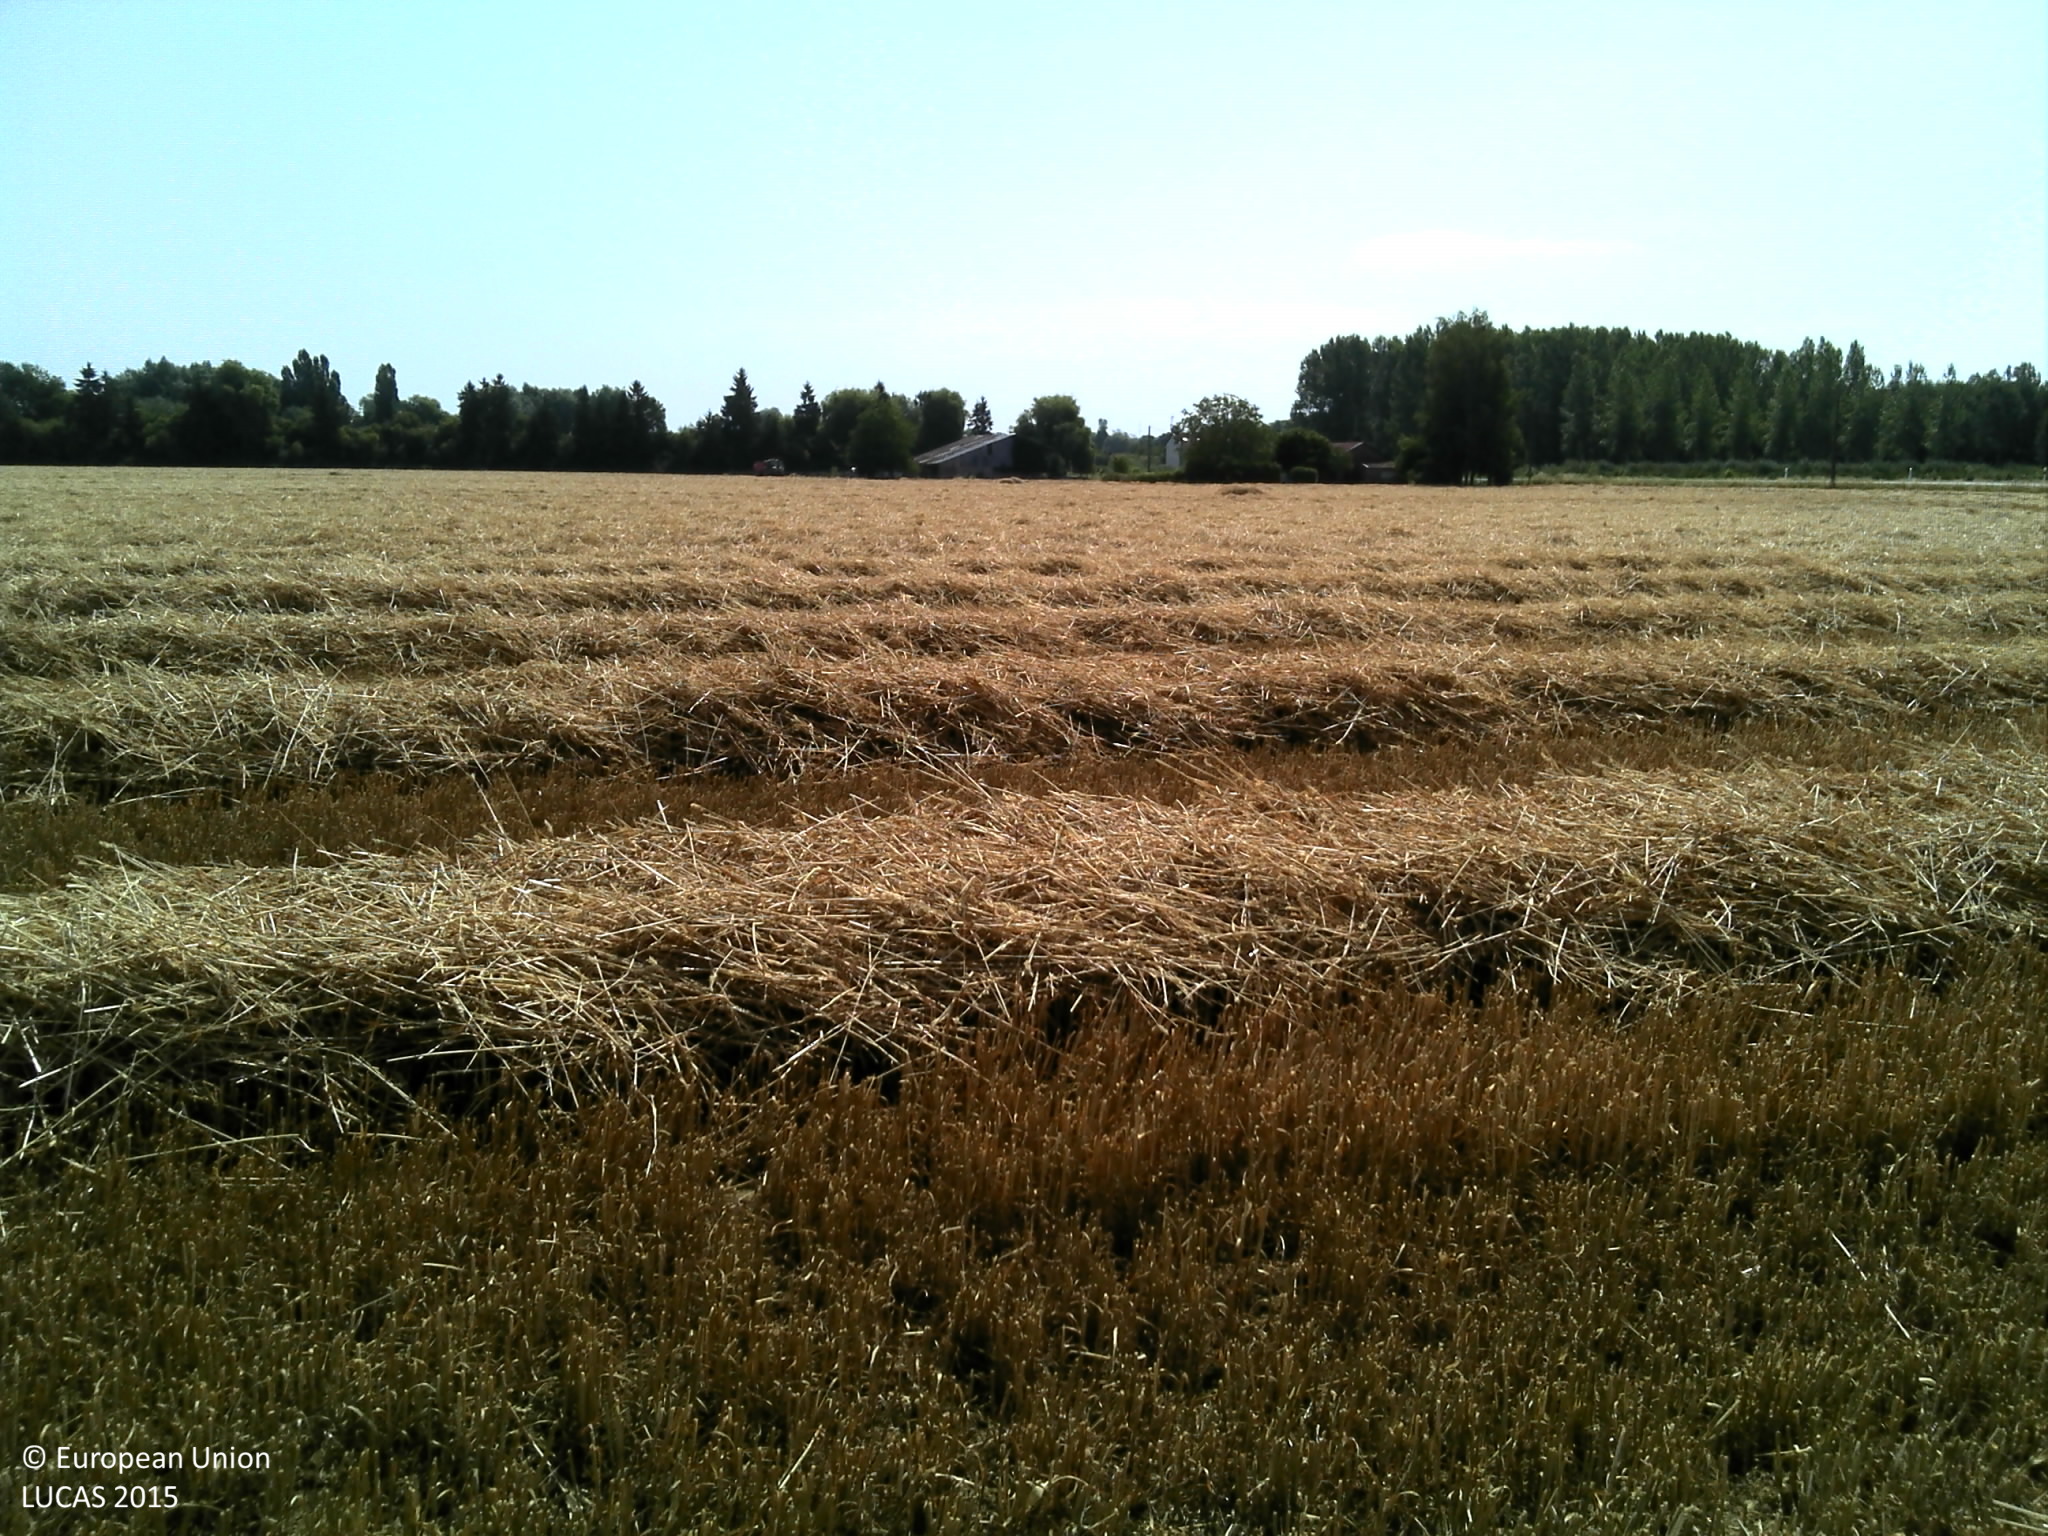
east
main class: Cropland
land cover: Common wheat
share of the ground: > 75 %
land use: Agriculture (excluding fallow land and kitchen gardens)
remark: Harvested field
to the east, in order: Common wheat
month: July
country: FR
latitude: 48.7903
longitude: 4.8935
